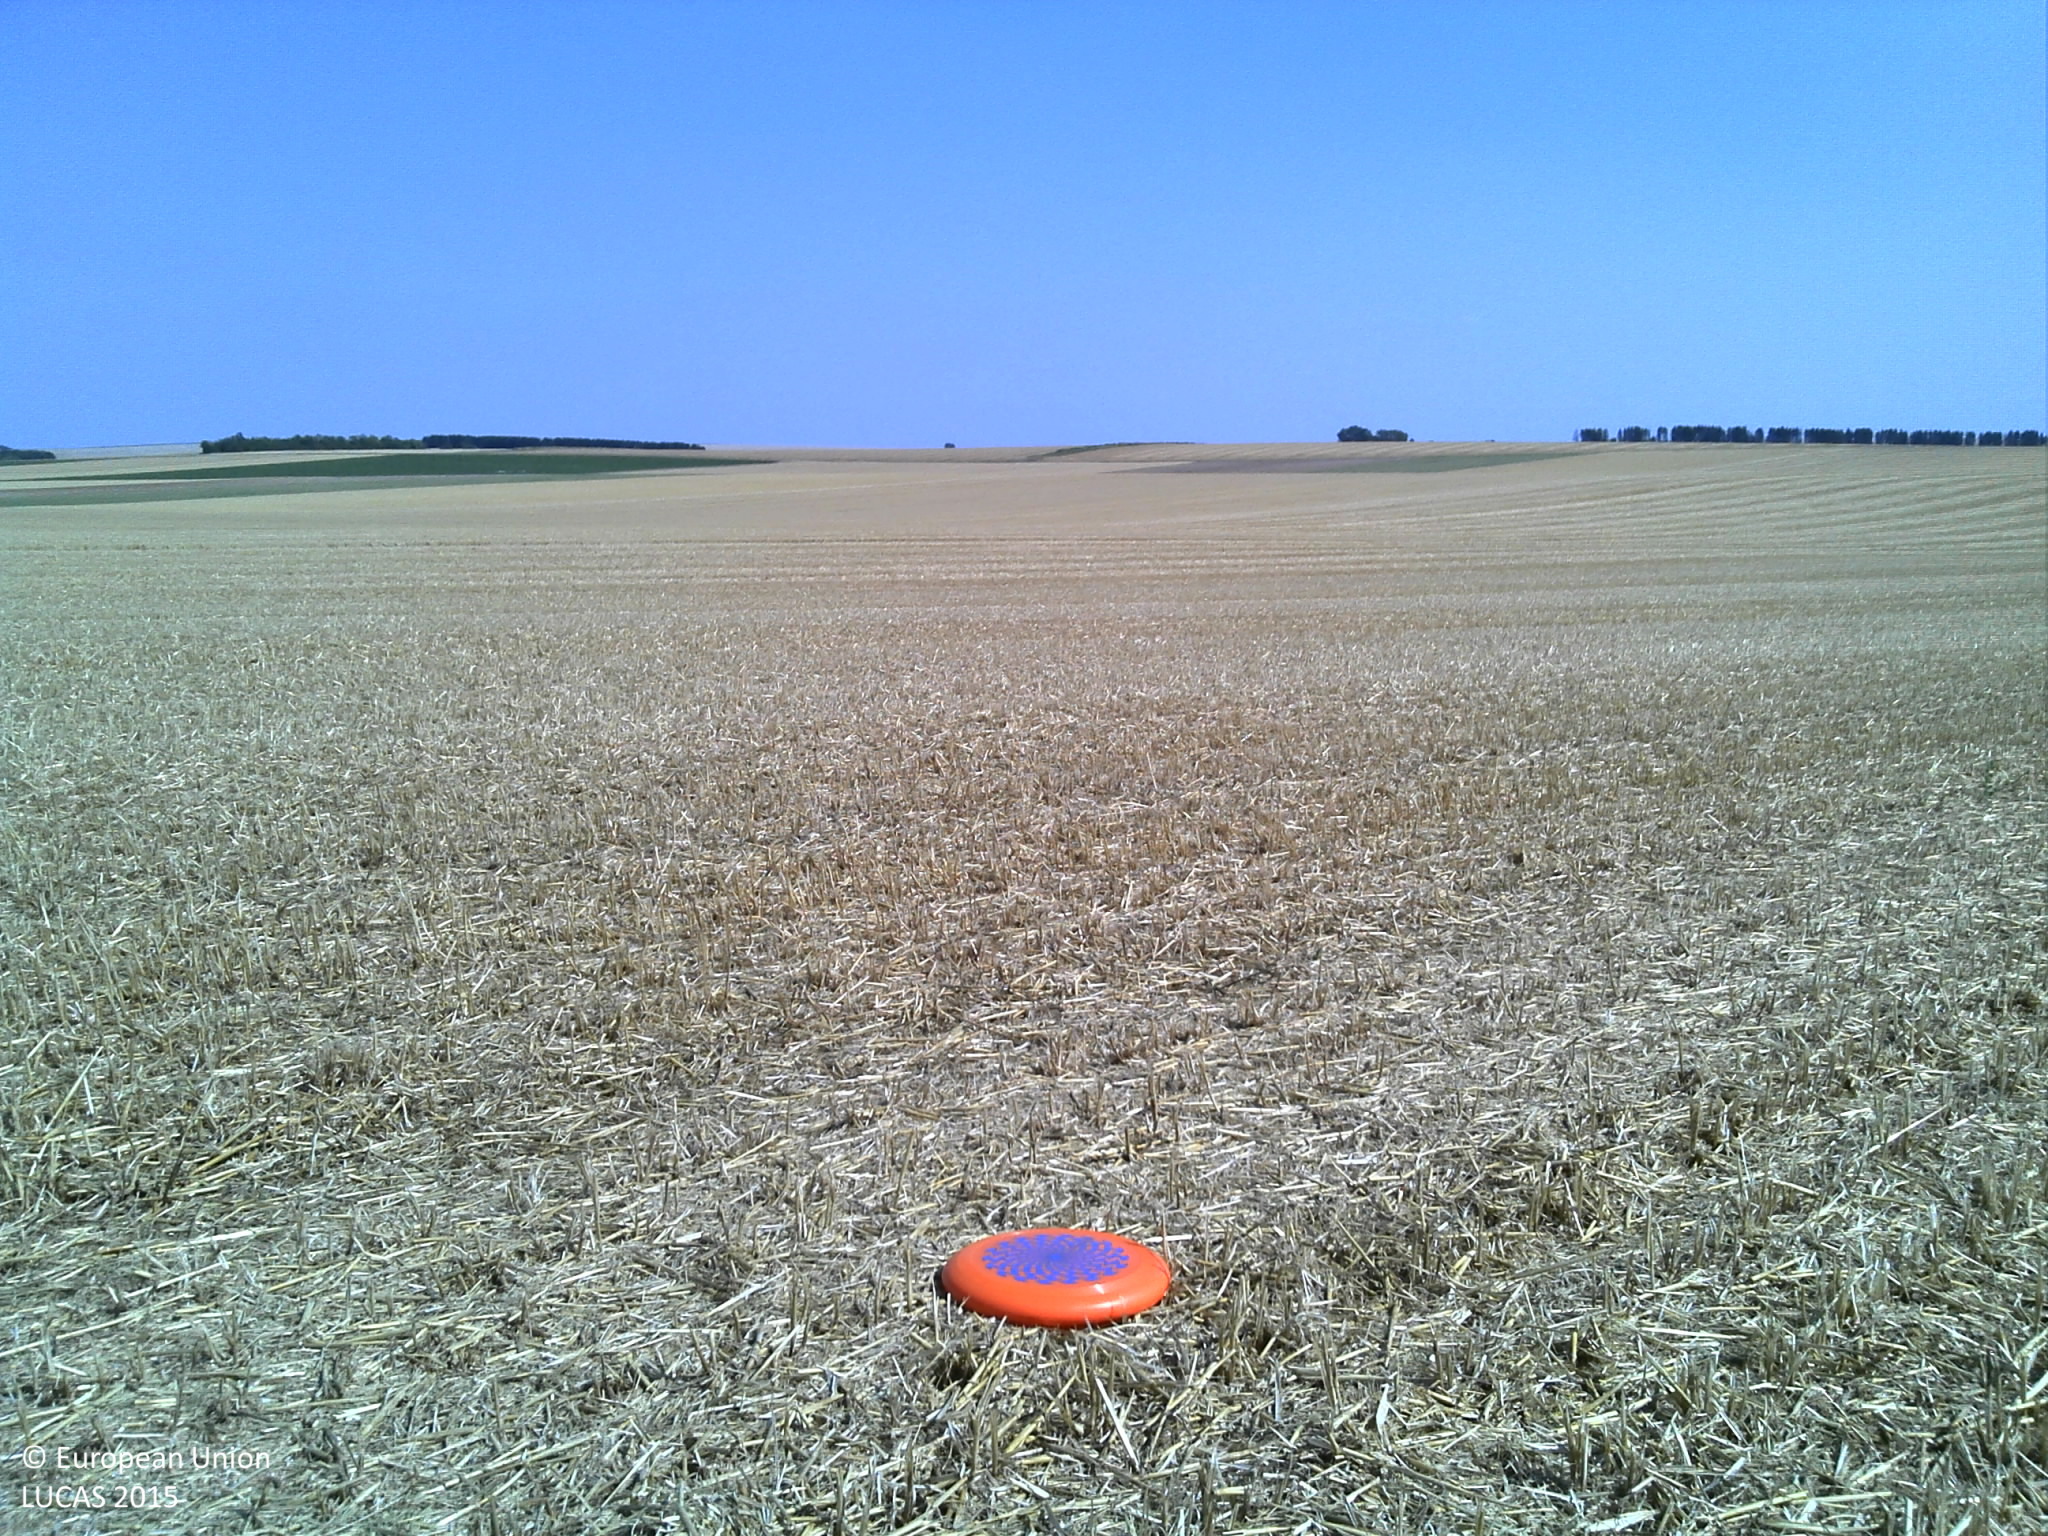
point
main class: Cropland
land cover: Common wheat
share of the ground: > 75 %
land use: Agriculture (excluding fallow land and kitchen gardens)
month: August
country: FR
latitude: 48.9262
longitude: 4.7153
